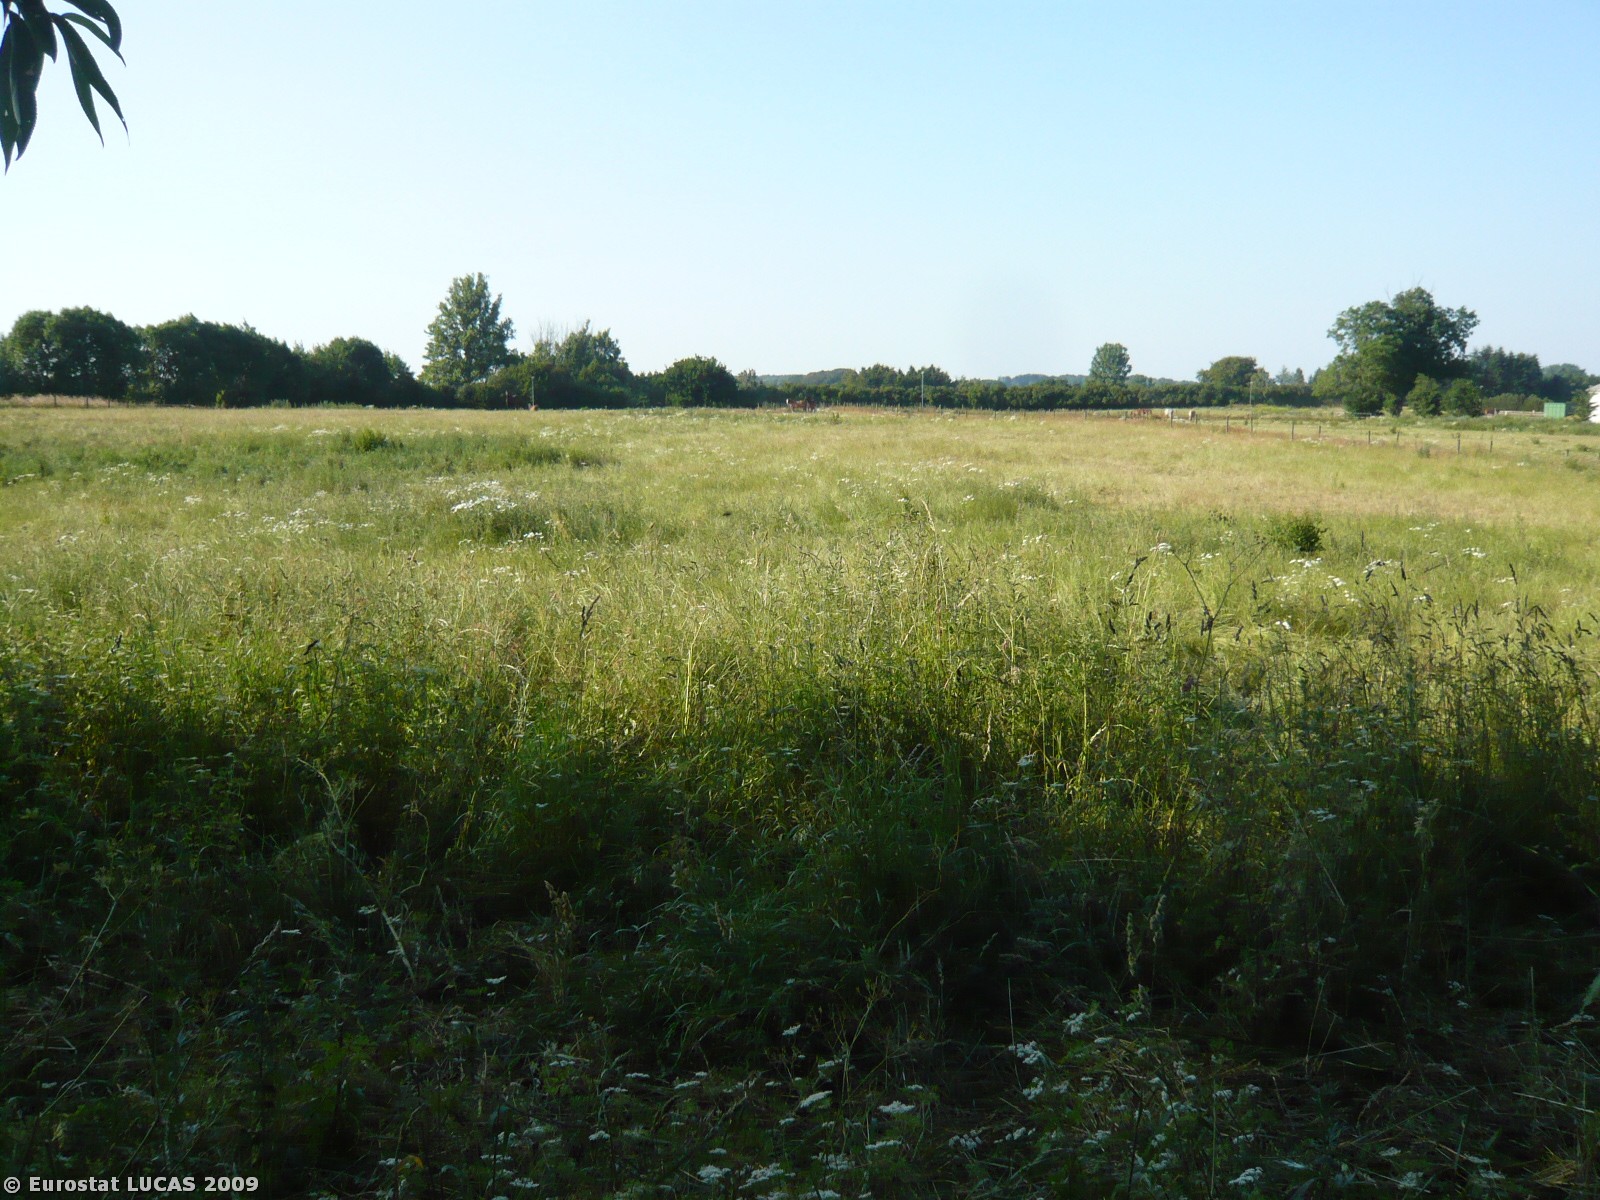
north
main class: Woodland
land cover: Broadleaved woodland
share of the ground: > 75 %
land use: Unused
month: July
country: DK
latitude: 55.4325
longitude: 10.2684
